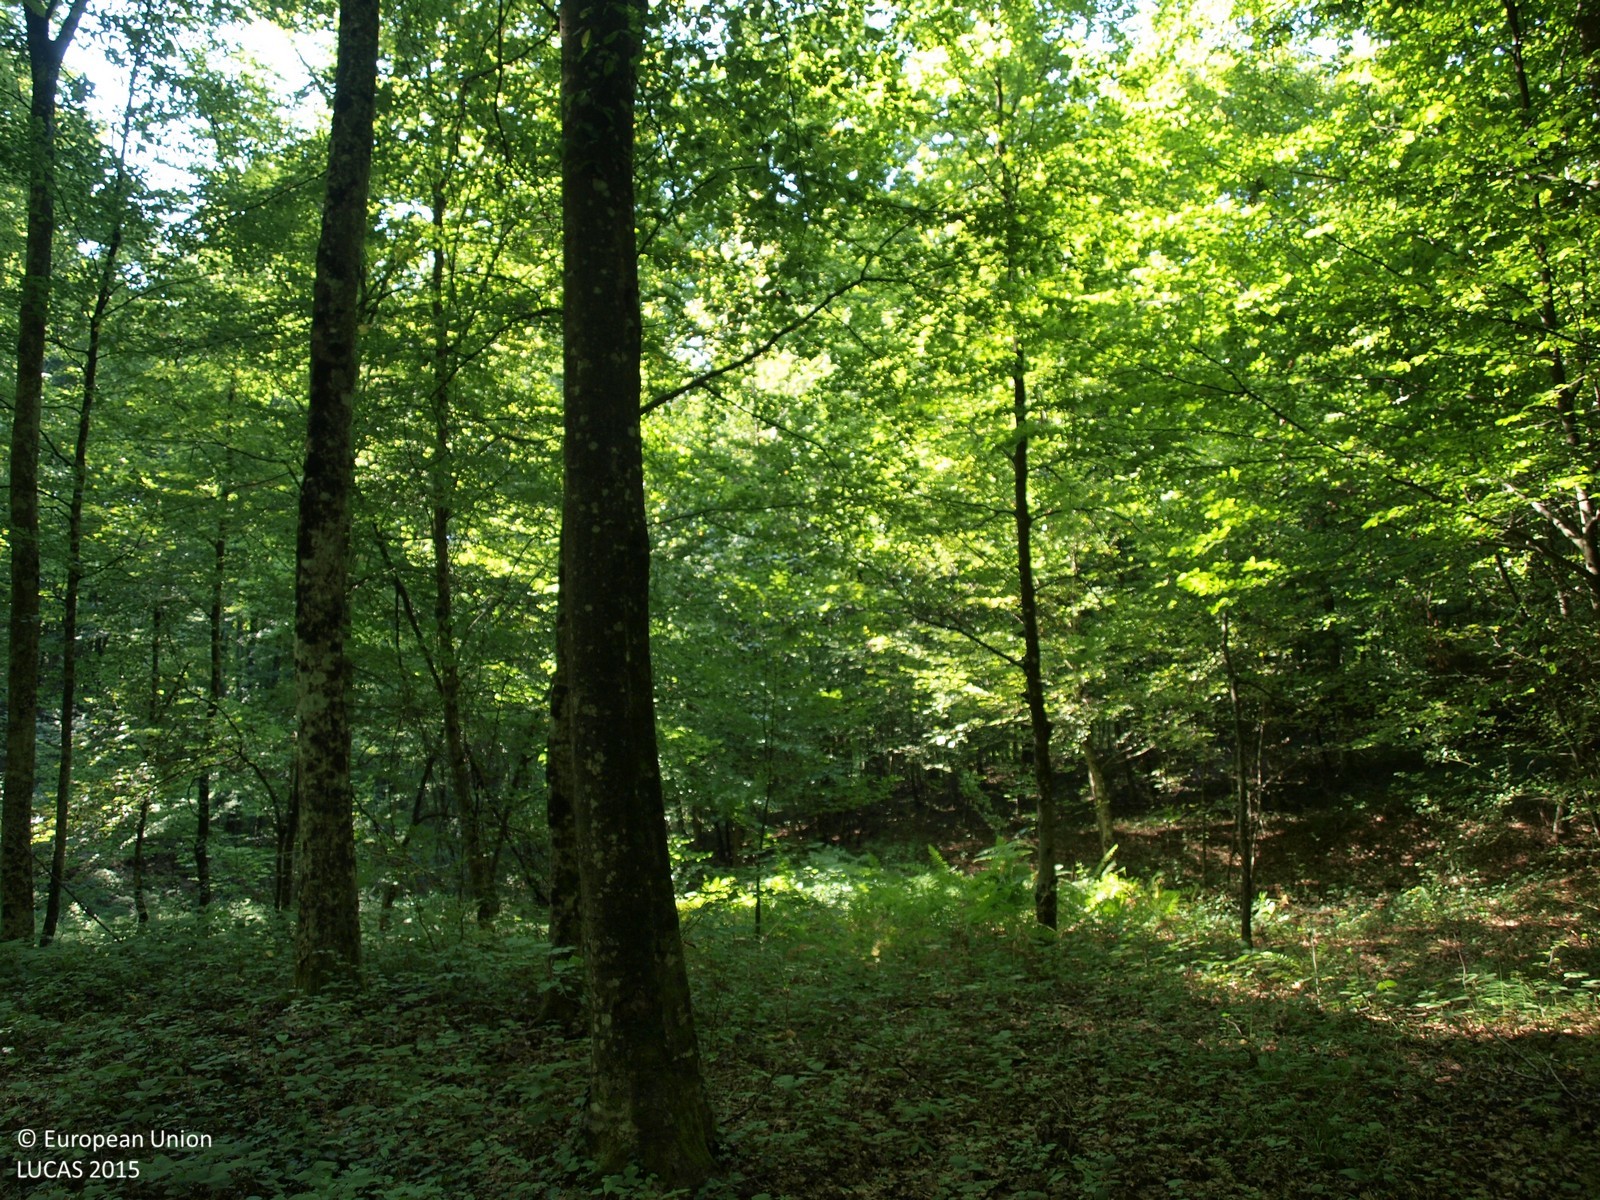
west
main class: Woodland
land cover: Broadleaved woodland
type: mesophytic deciduous forest
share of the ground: > 75 %
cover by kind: broadleaved forest trees 100 %
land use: Forestry
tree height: > 5 m
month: September
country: HR
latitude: 45.5488
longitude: 16.0301
